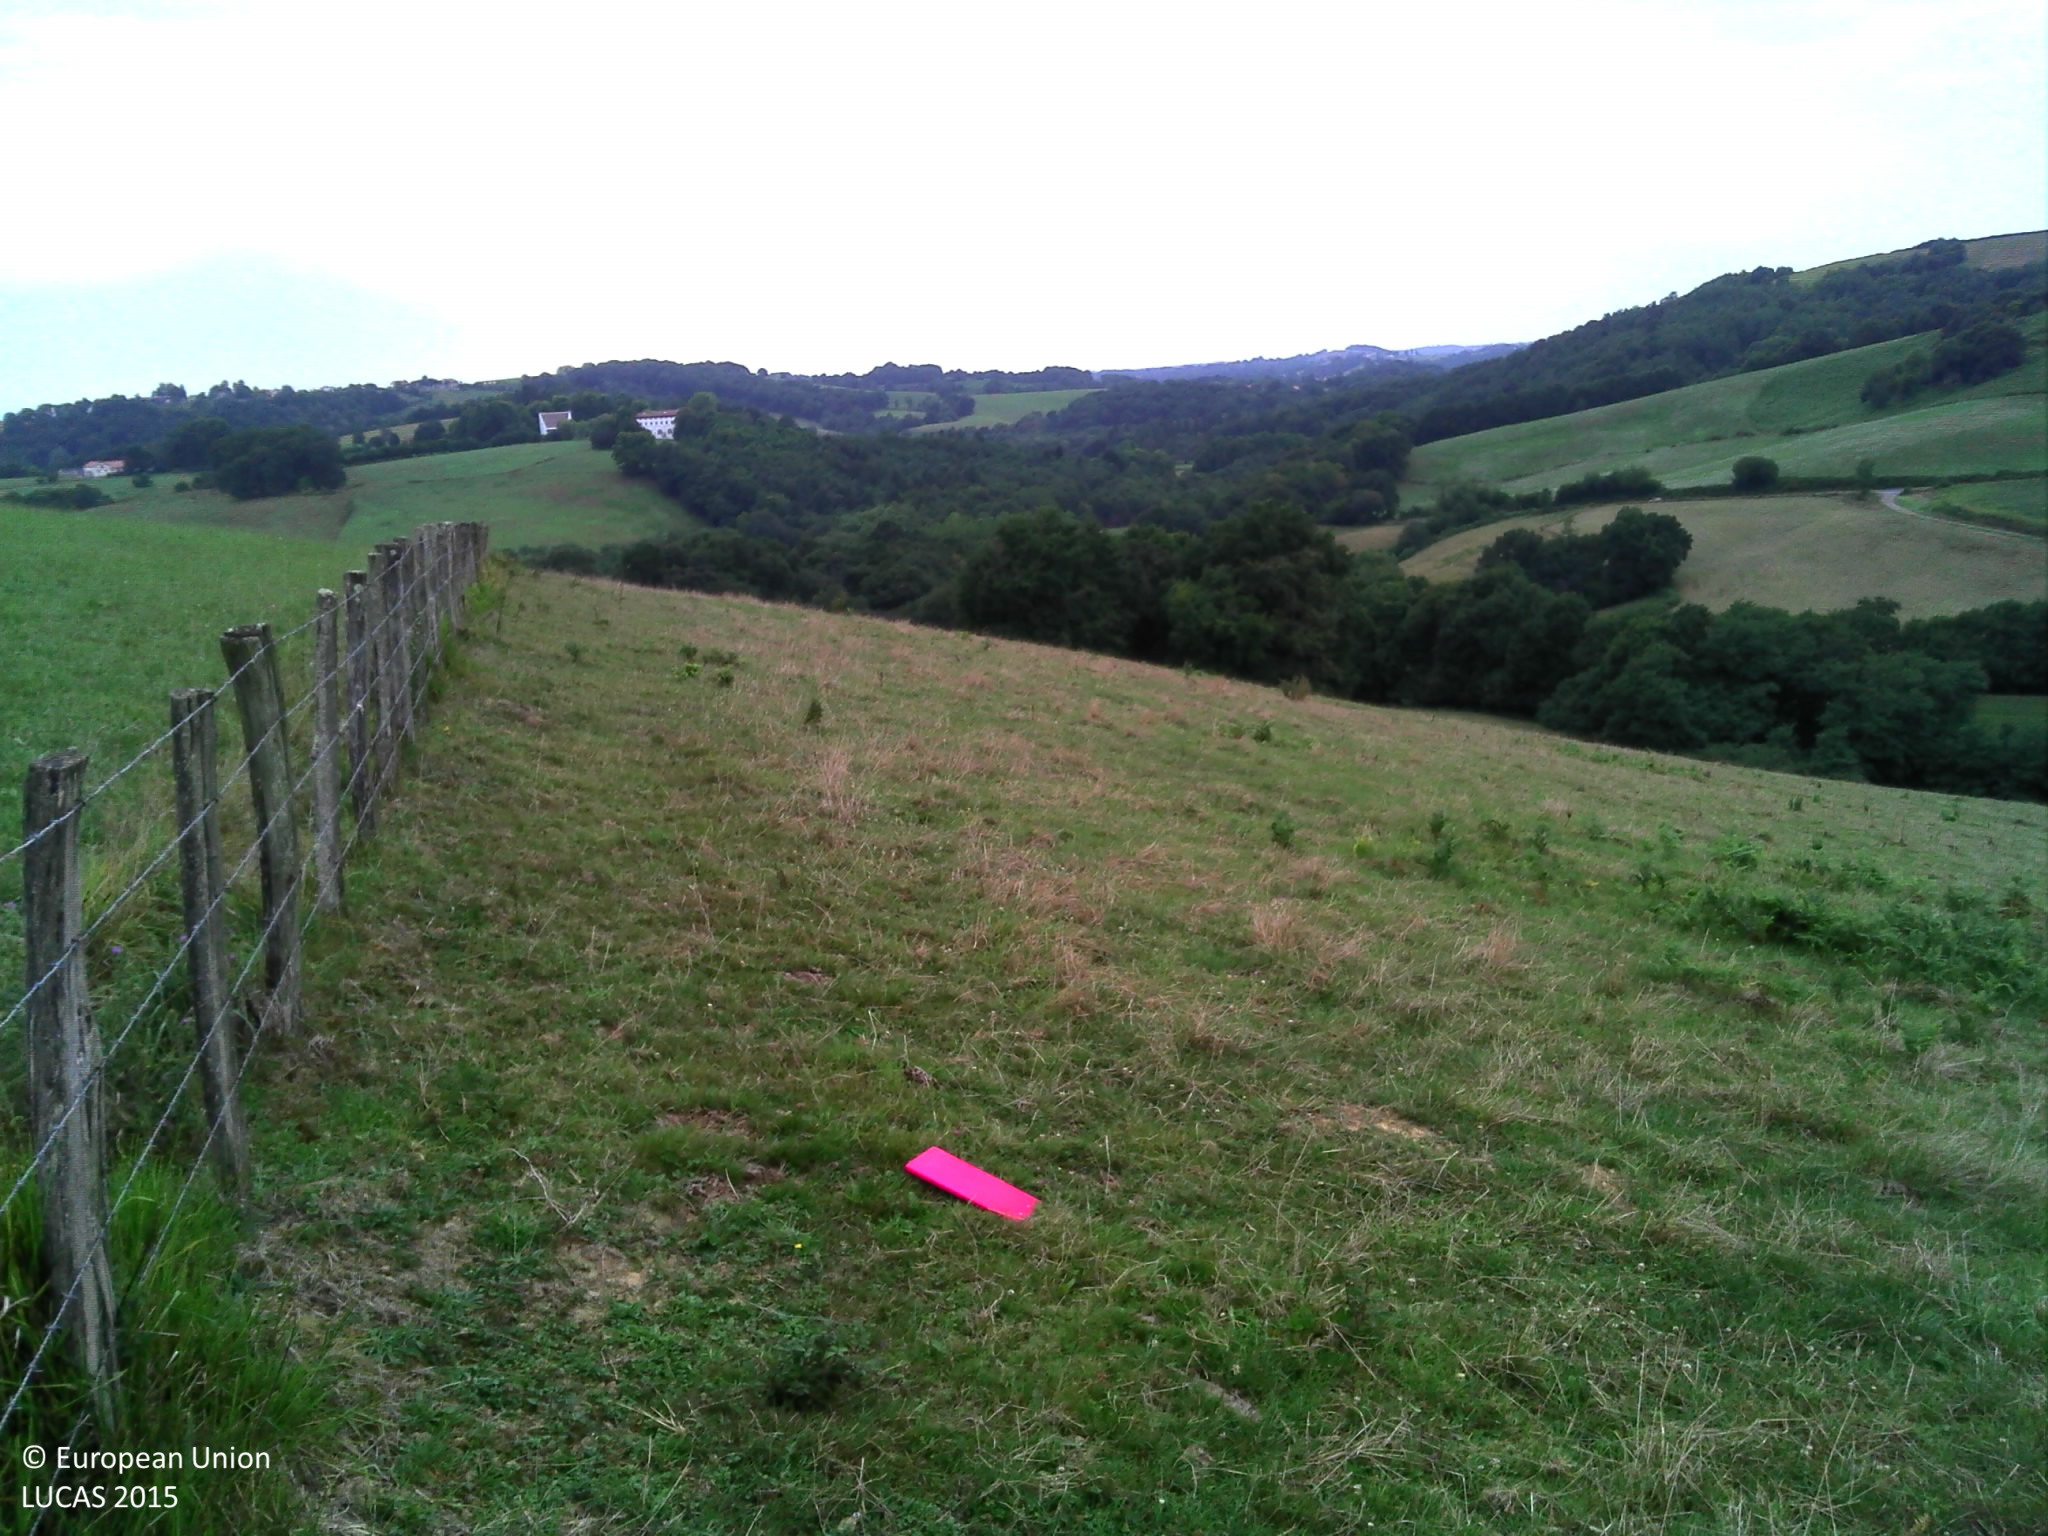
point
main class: Grassland
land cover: Grassland without tree/shrub cover
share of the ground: > 75 %
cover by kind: herbaceous plants 100 %
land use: Agriculture (excluding fallow land and kitchen gardens)
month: August
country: FR
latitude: 43.4458
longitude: -1.2476
